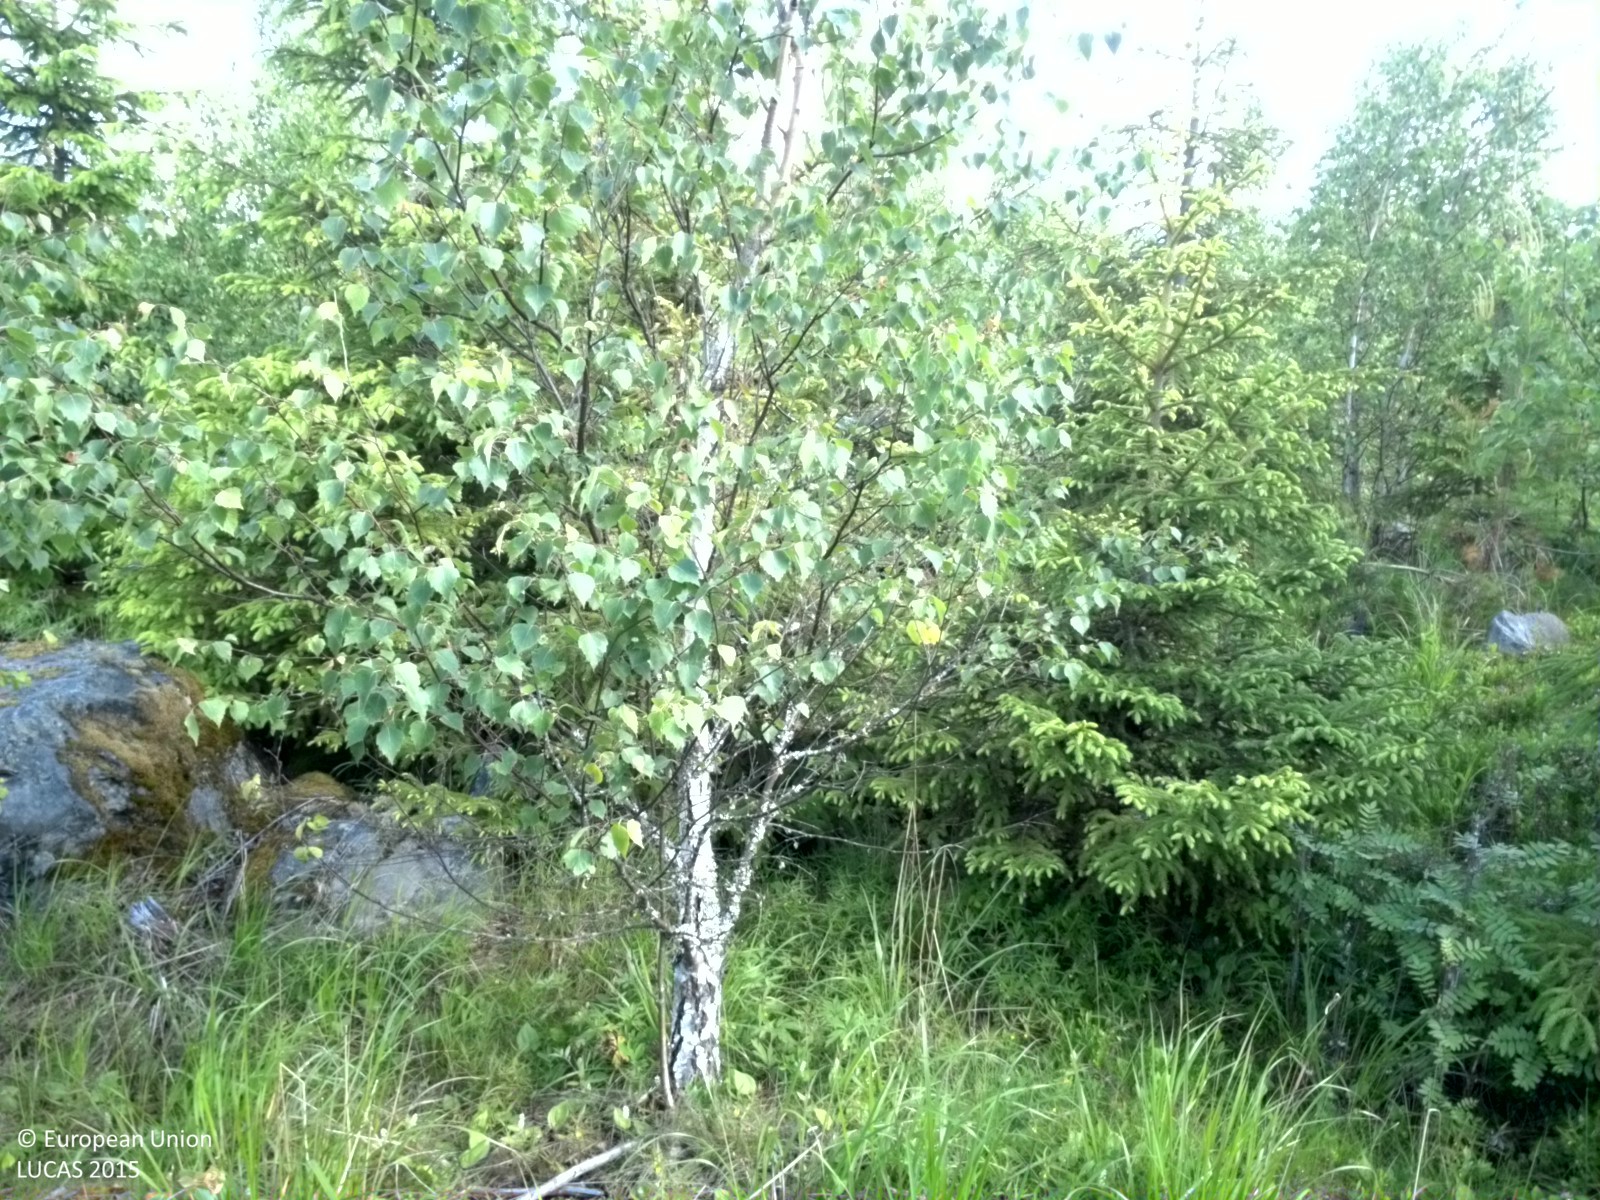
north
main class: Woodland
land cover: Spruce dominated mixed woodland
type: boreal forest
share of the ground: 50 - 75 %
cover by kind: broadleaved forest trees 30 %, coniferous forest trees 25 %, herbaceous plants 20 %, lichens and mosses 10 %, consolidated bare surface 10 %, shrubs 5 %
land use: Forestry
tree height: < 5 m
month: June
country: SE
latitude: 60.1500
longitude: 17.7204
